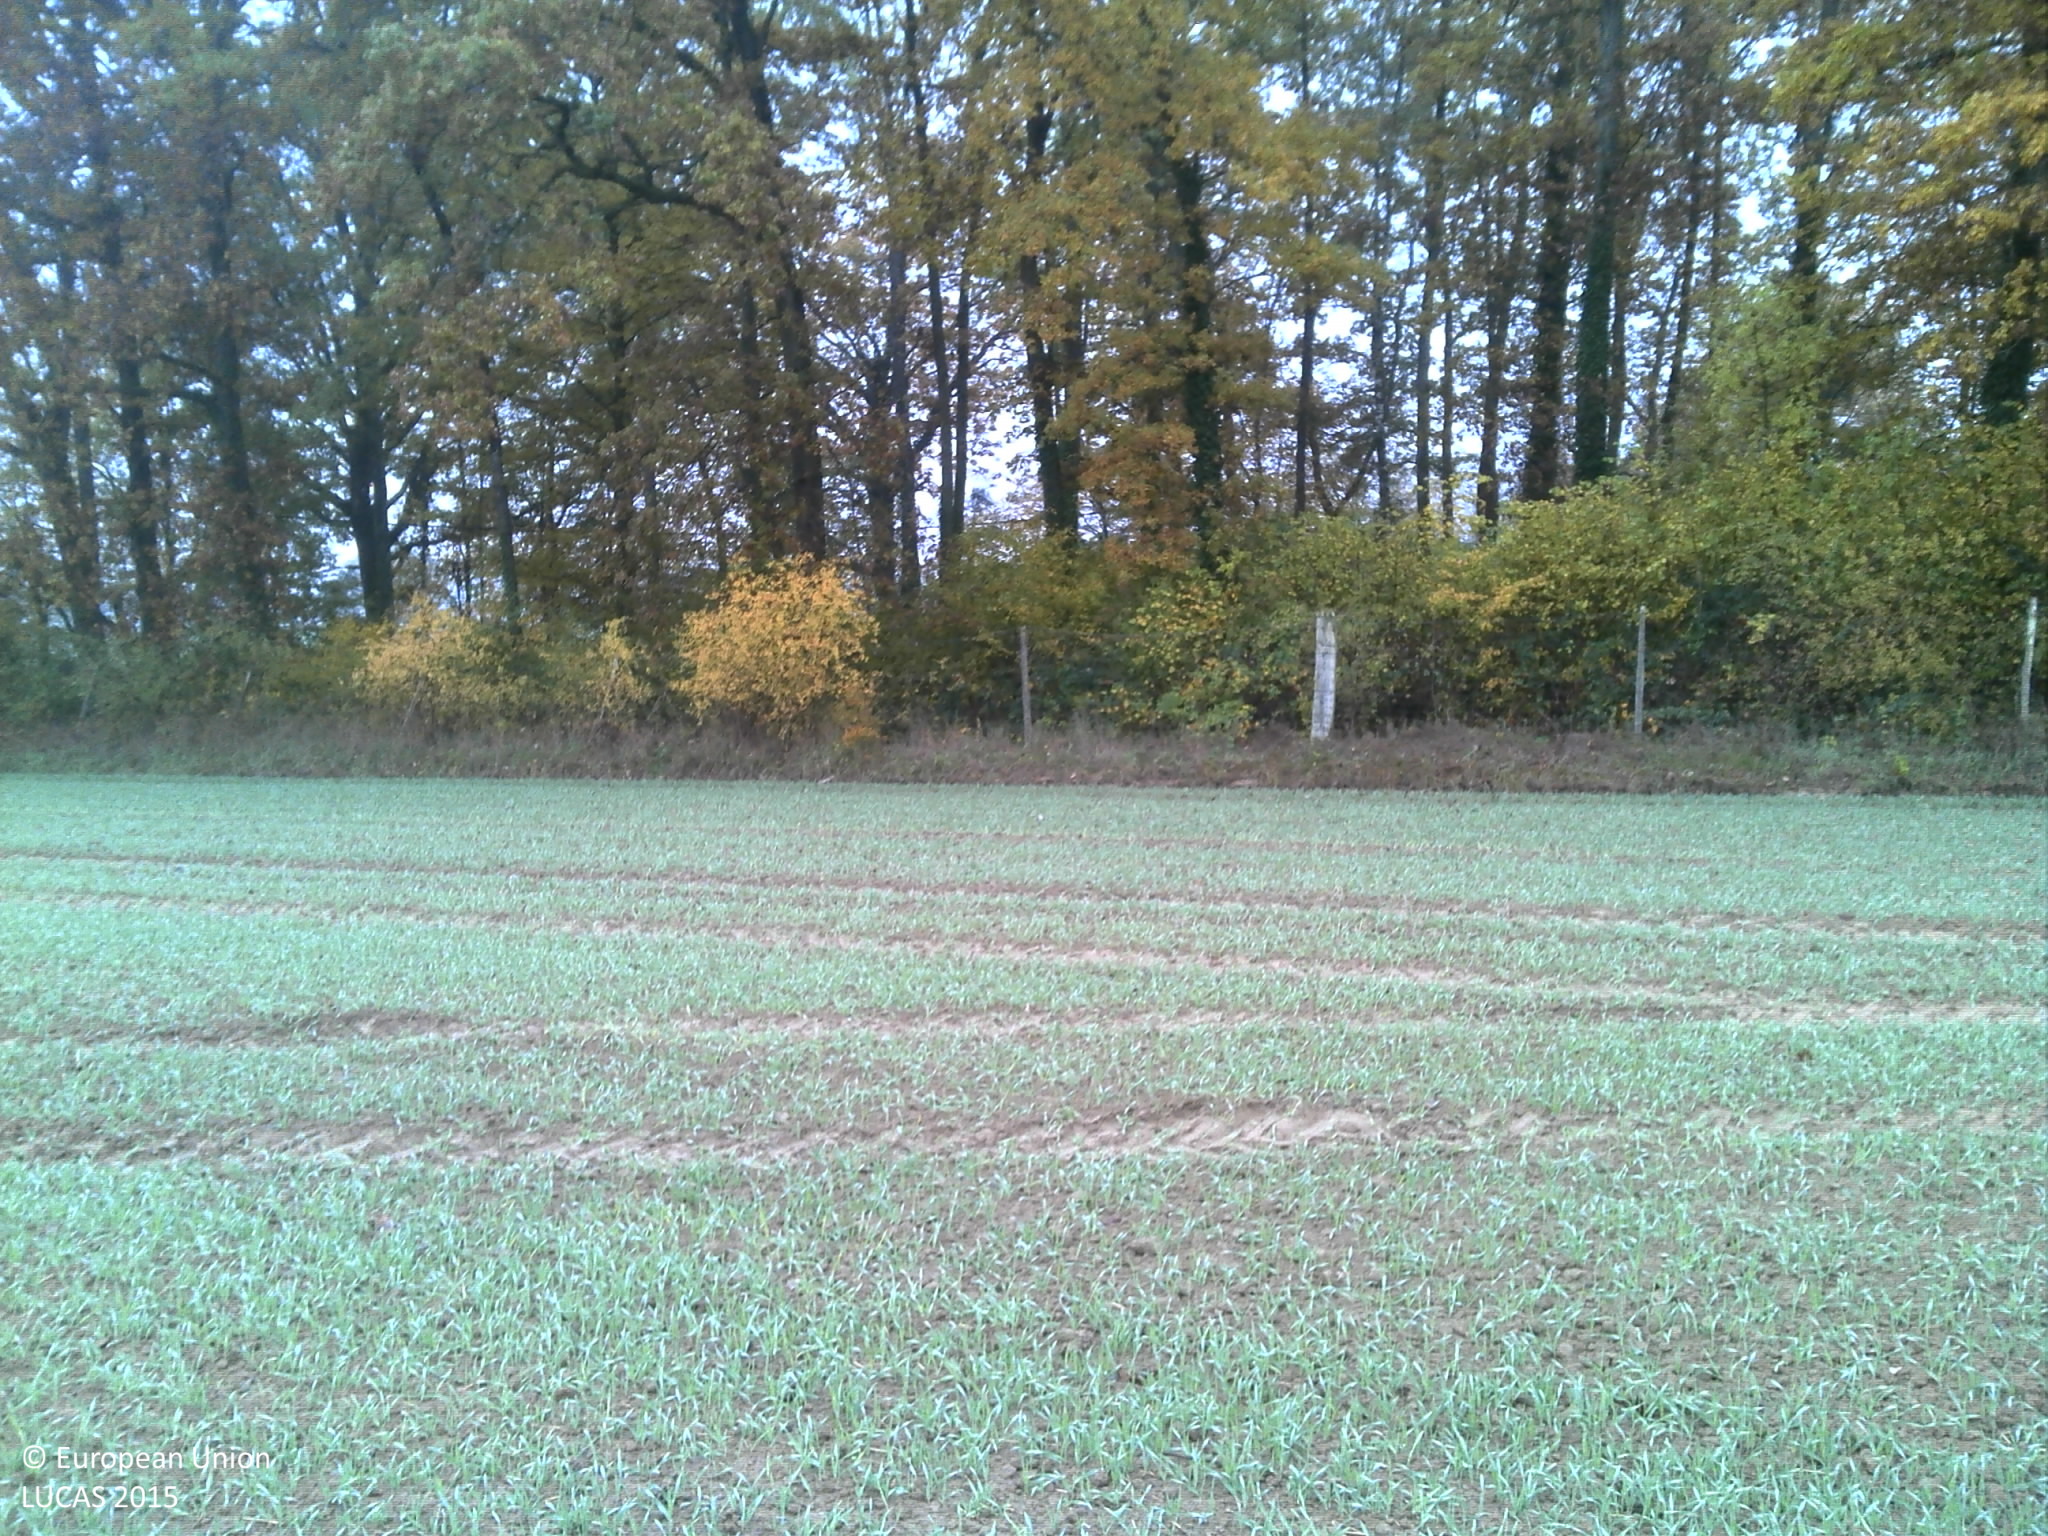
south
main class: Cropland
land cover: Common wheat
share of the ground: > 75 %
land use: Agriculture (excluding fallow land and kitchen gardens)
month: October
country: FR
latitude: 47.1222
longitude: 5.0844
